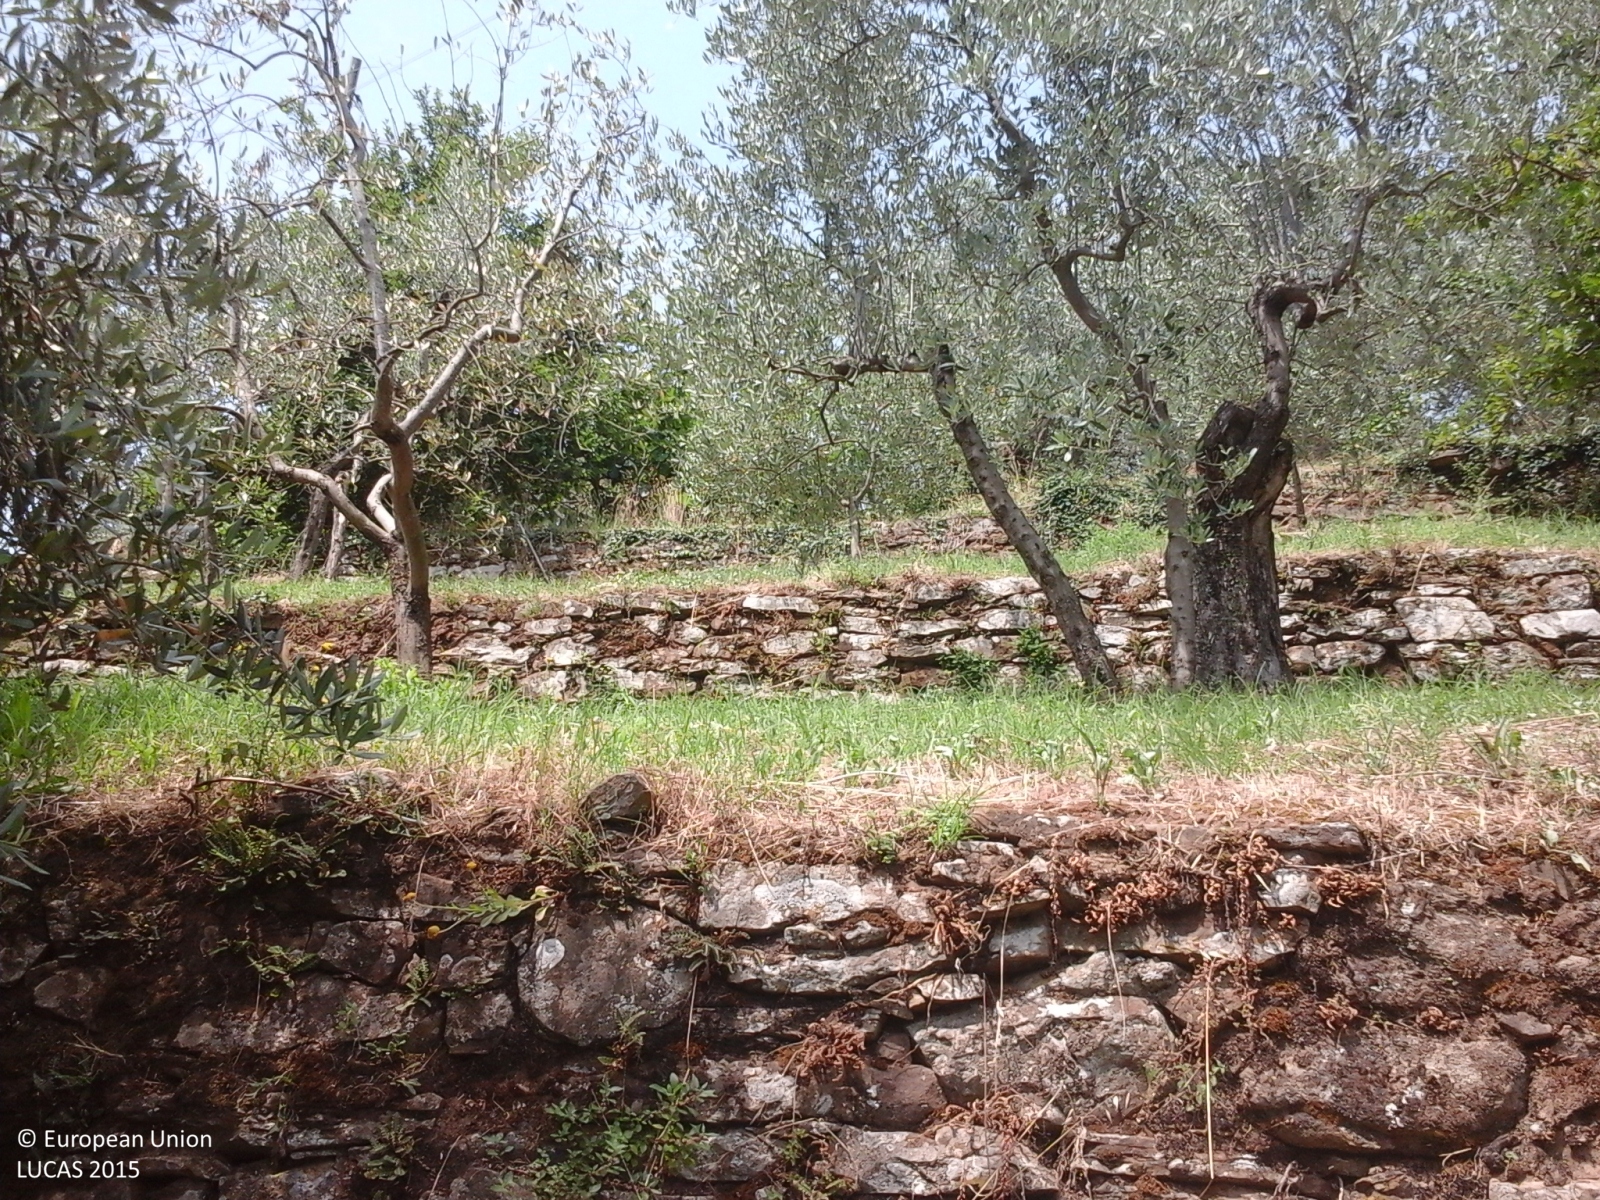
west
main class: Cropland
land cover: Olive groves
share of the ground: 10 - 25 %
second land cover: Grassland without tree/shrub cover
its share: 25 - 50 %
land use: Agriculture (excluding fallow land and kitchen gardens)
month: June
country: IT
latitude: 43.8052
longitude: 10.9298
